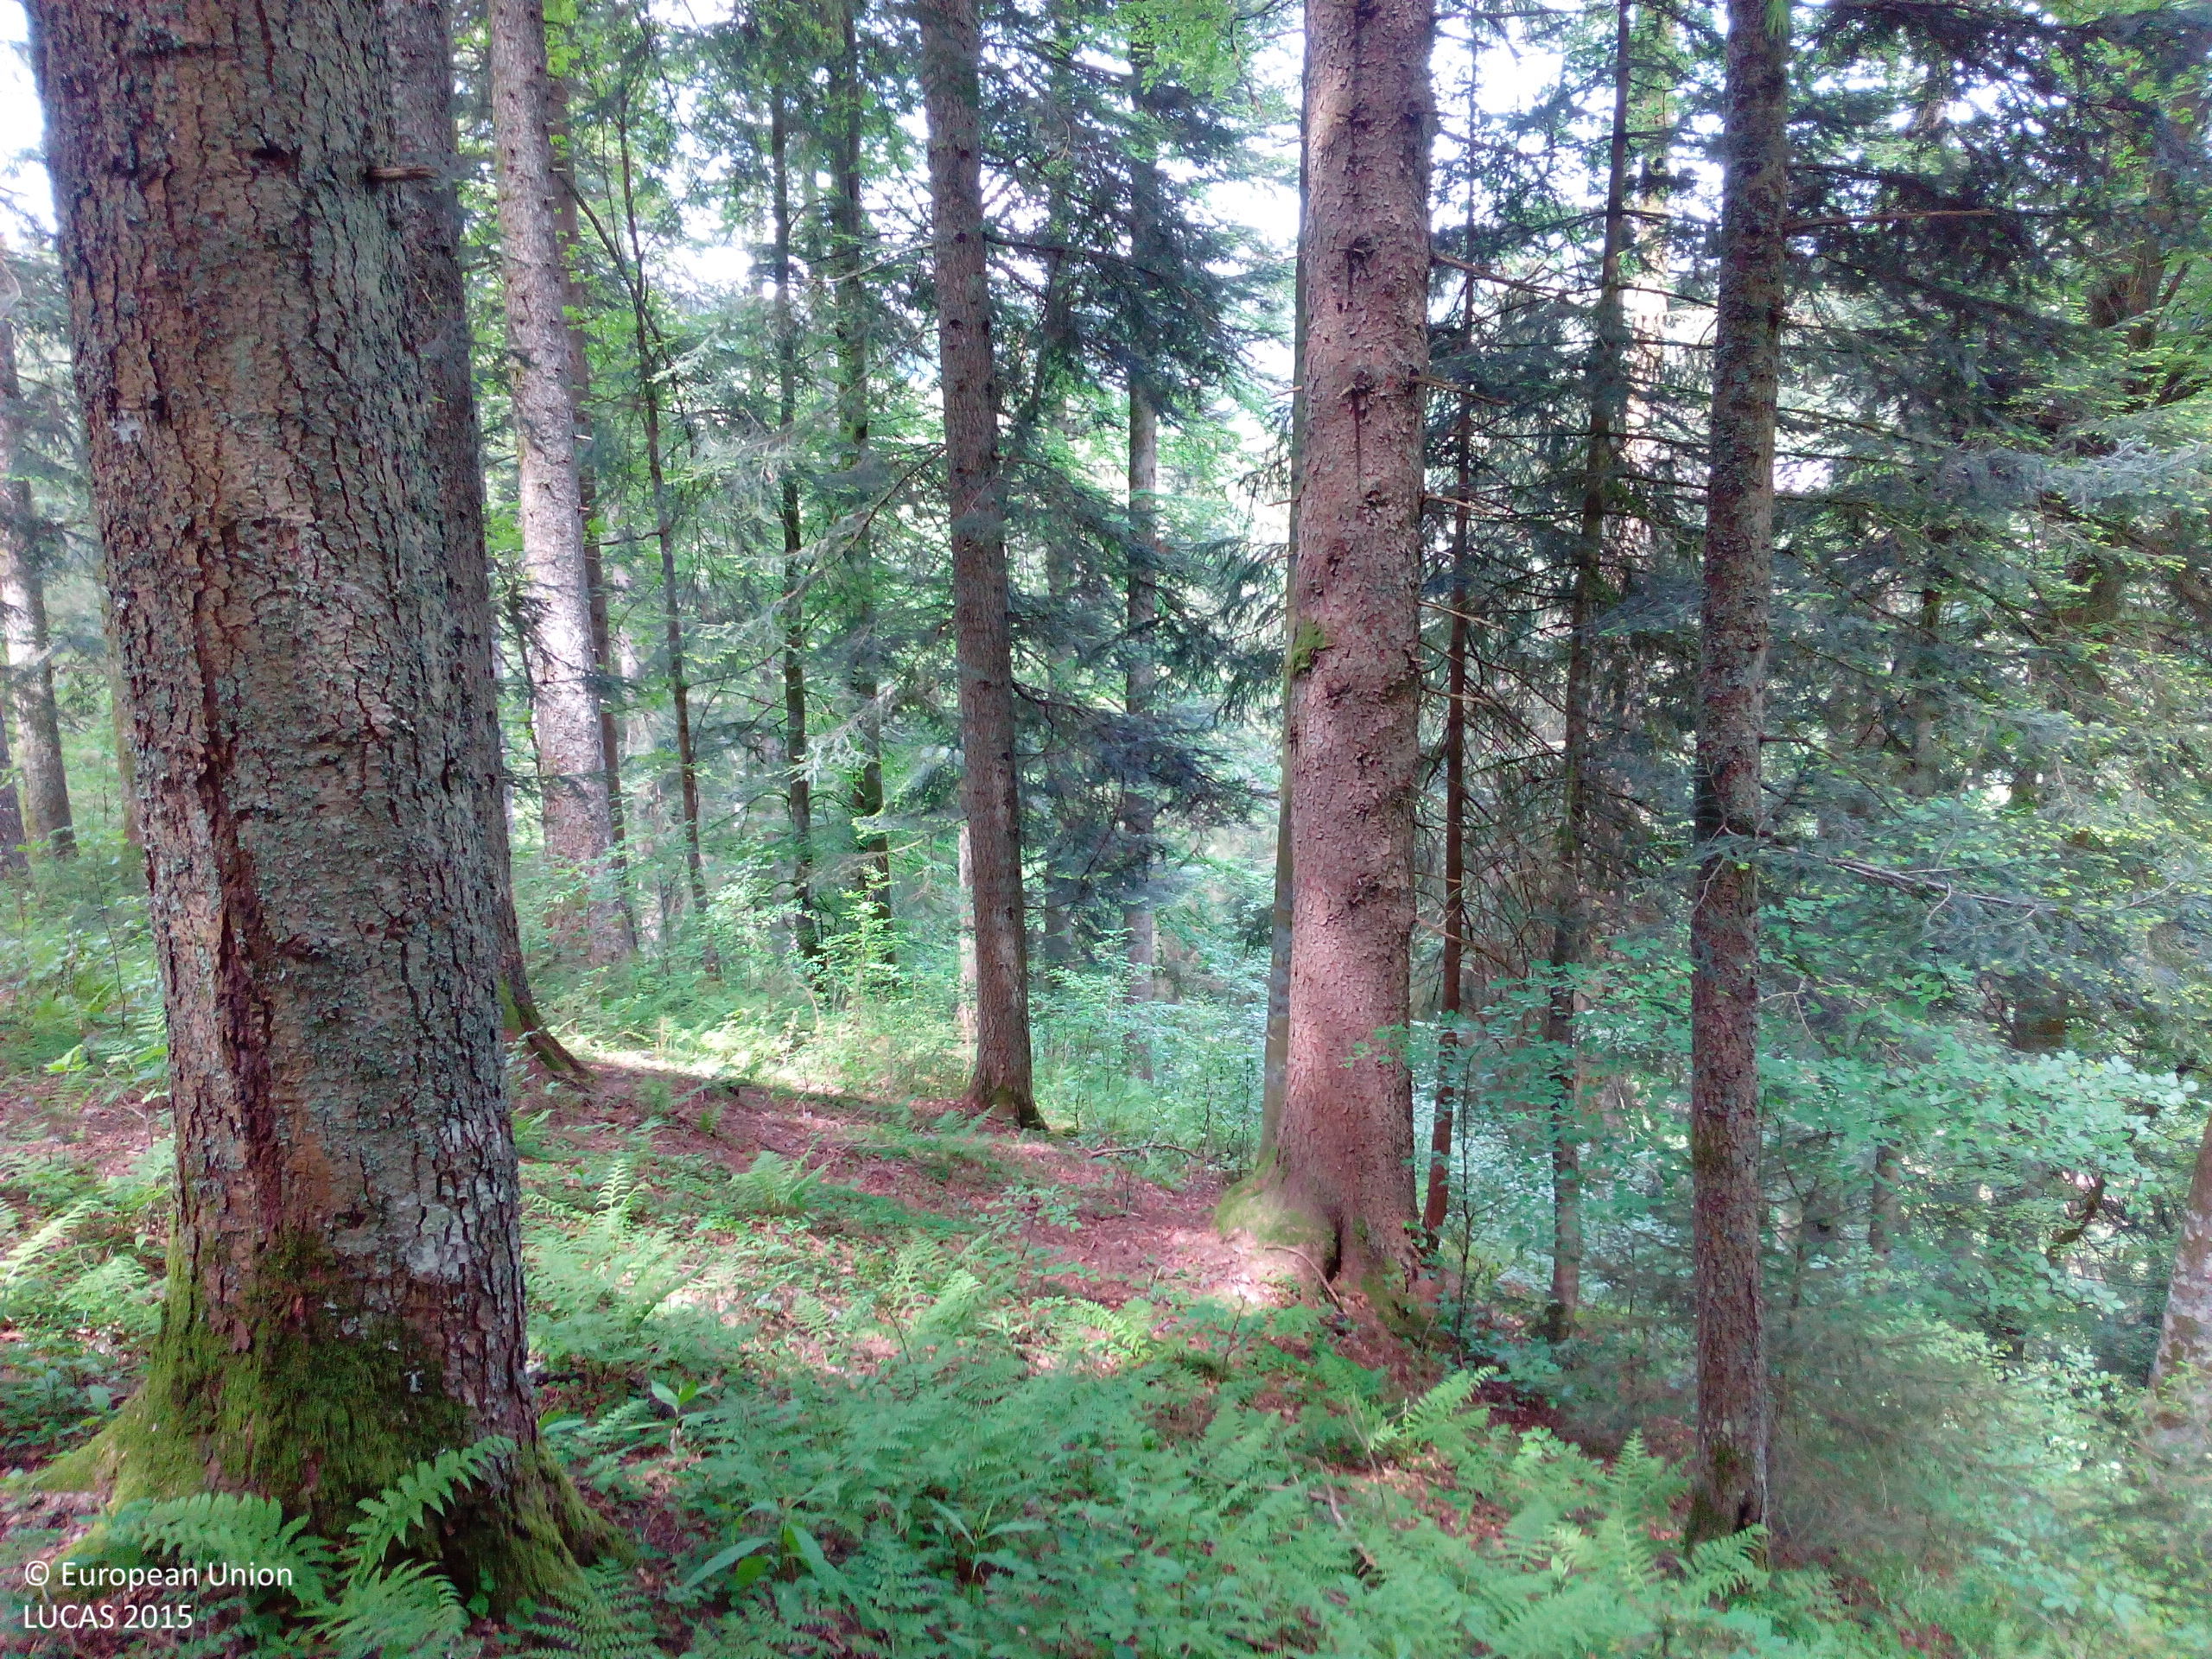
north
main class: Woodland
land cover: Other mixed woodland
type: hemiboreal forest and nemoral coniferous forest and mixed broadleaved-coniferous forest
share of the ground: > 75 %
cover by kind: coniferous forest trees 75 %, broadleaved forest trees 25 %
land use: Forestry
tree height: > 5 m
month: May
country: DE
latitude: 48.0107
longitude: 8.1913
